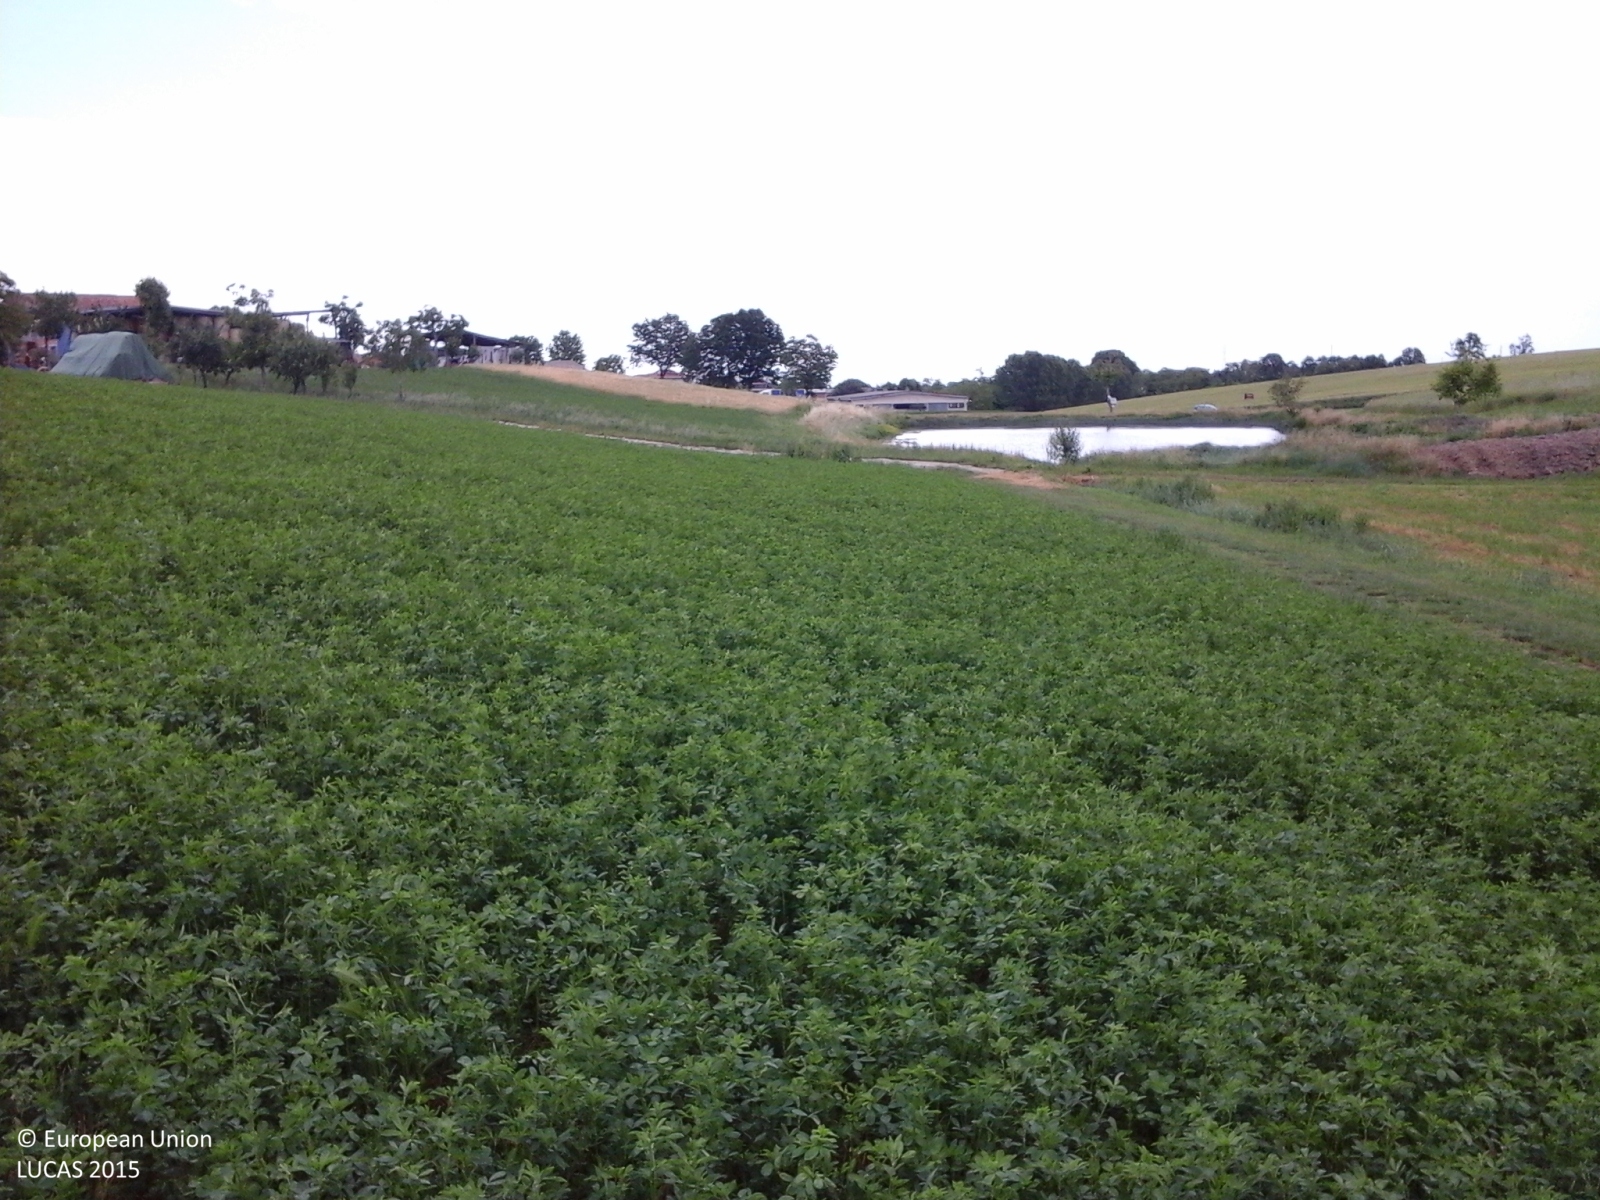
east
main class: Cropland
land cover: Barley
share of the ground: > 75 %
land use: Agriculture (excluding fallow land and kitchen gardens)
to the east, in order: Barley; Lucerne; Spontaneously vegetated surfaces; Lucerne; Barley; Tracks; Lucerne; Grass margins; Lines of trees; Paved roads, cycling and walking lanes; Grass margins; Lucerne
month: May
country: IT
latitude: 44.6189
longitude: 10.6665
